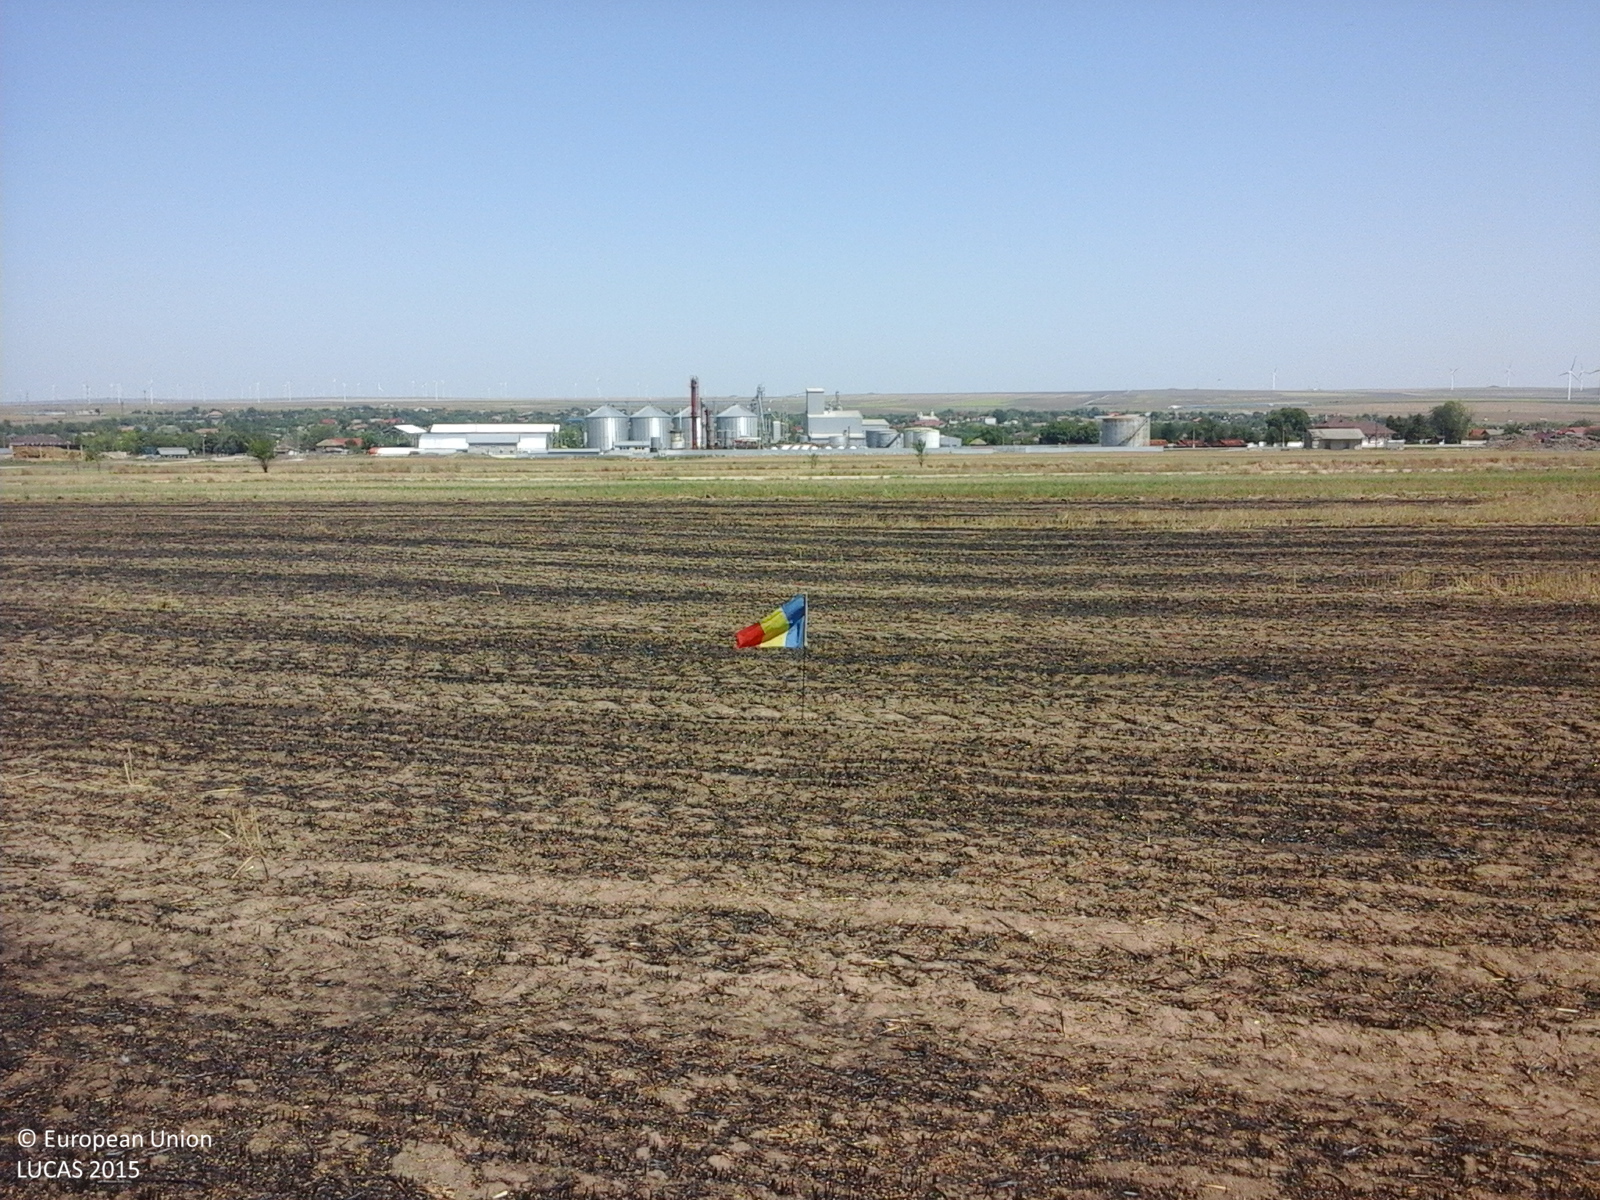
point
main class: Cropland
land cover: Common wheat
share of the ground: < 10 %
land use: Agriculture (excluding fallow land and kitchen gardens)
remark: Burnt area
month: August
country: RO
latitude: 44.3718
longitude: 28.3775
